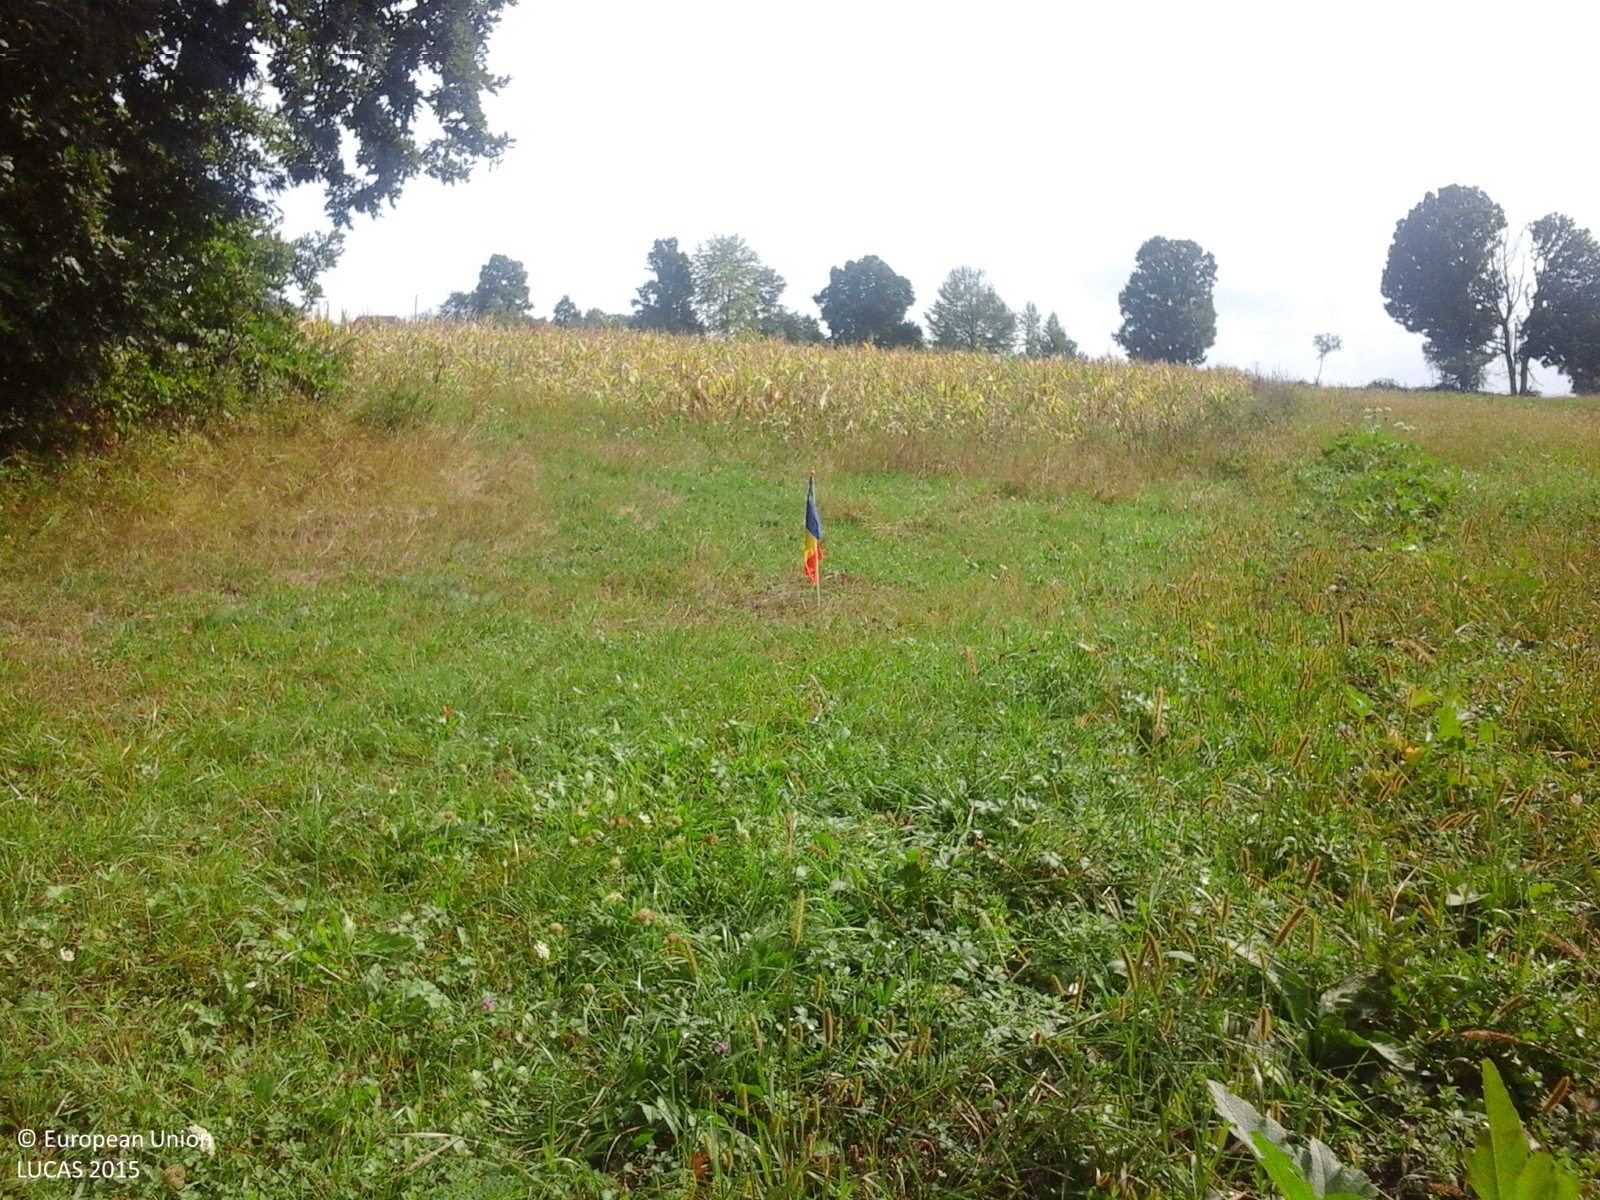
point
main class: Grassland
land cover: Grassland without tree/shrub cover
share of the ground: > 75 %
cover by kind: herbaceous plants 100 %
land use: Agriculture (excluding fallow land and kitchen gardens)
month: September
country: RO
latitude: 46.9565
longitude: 22.5514
